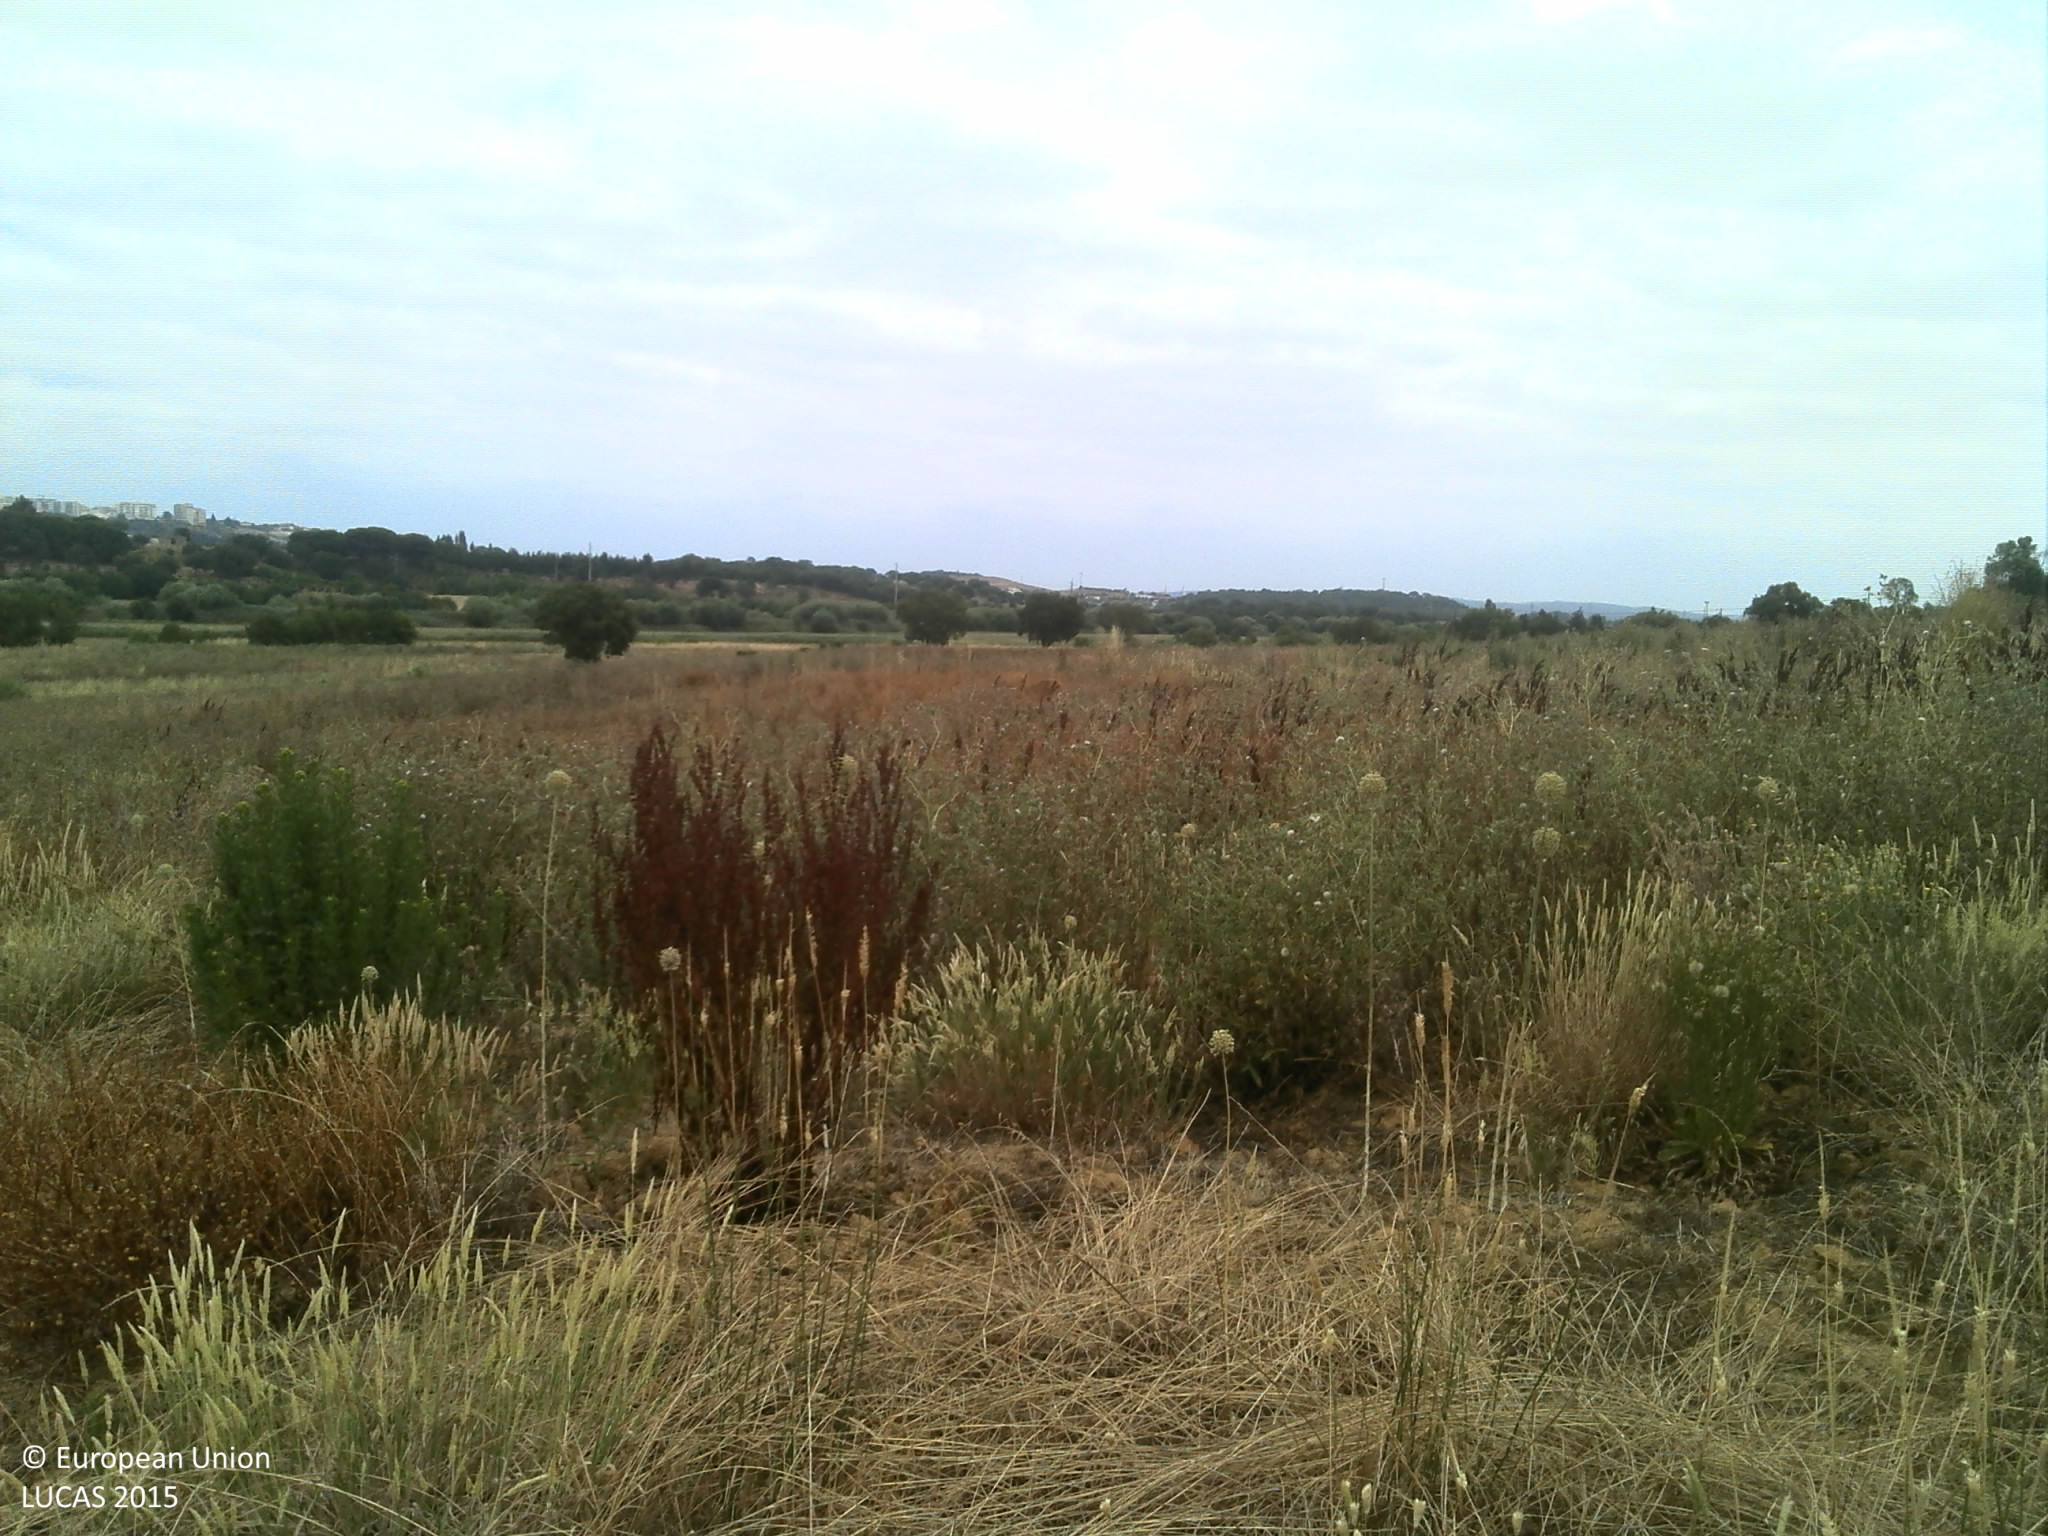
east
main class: Shrubland
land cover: Shrubland without tree cover
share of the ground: 50 - 75 %
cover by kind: shrubs 60 %, unconsolidated bare surface 30 %, herbaceous plants 10 %
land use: Abandoned areas
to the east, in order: Shrubland without tree cover; Tracks; Grassland without tree/shrub cover; Tracks; Grass margins; Ditches and canals; Grass margins; Shrubland without tree cover
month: June
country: PT
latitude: 39.2221
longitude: -8.7339
